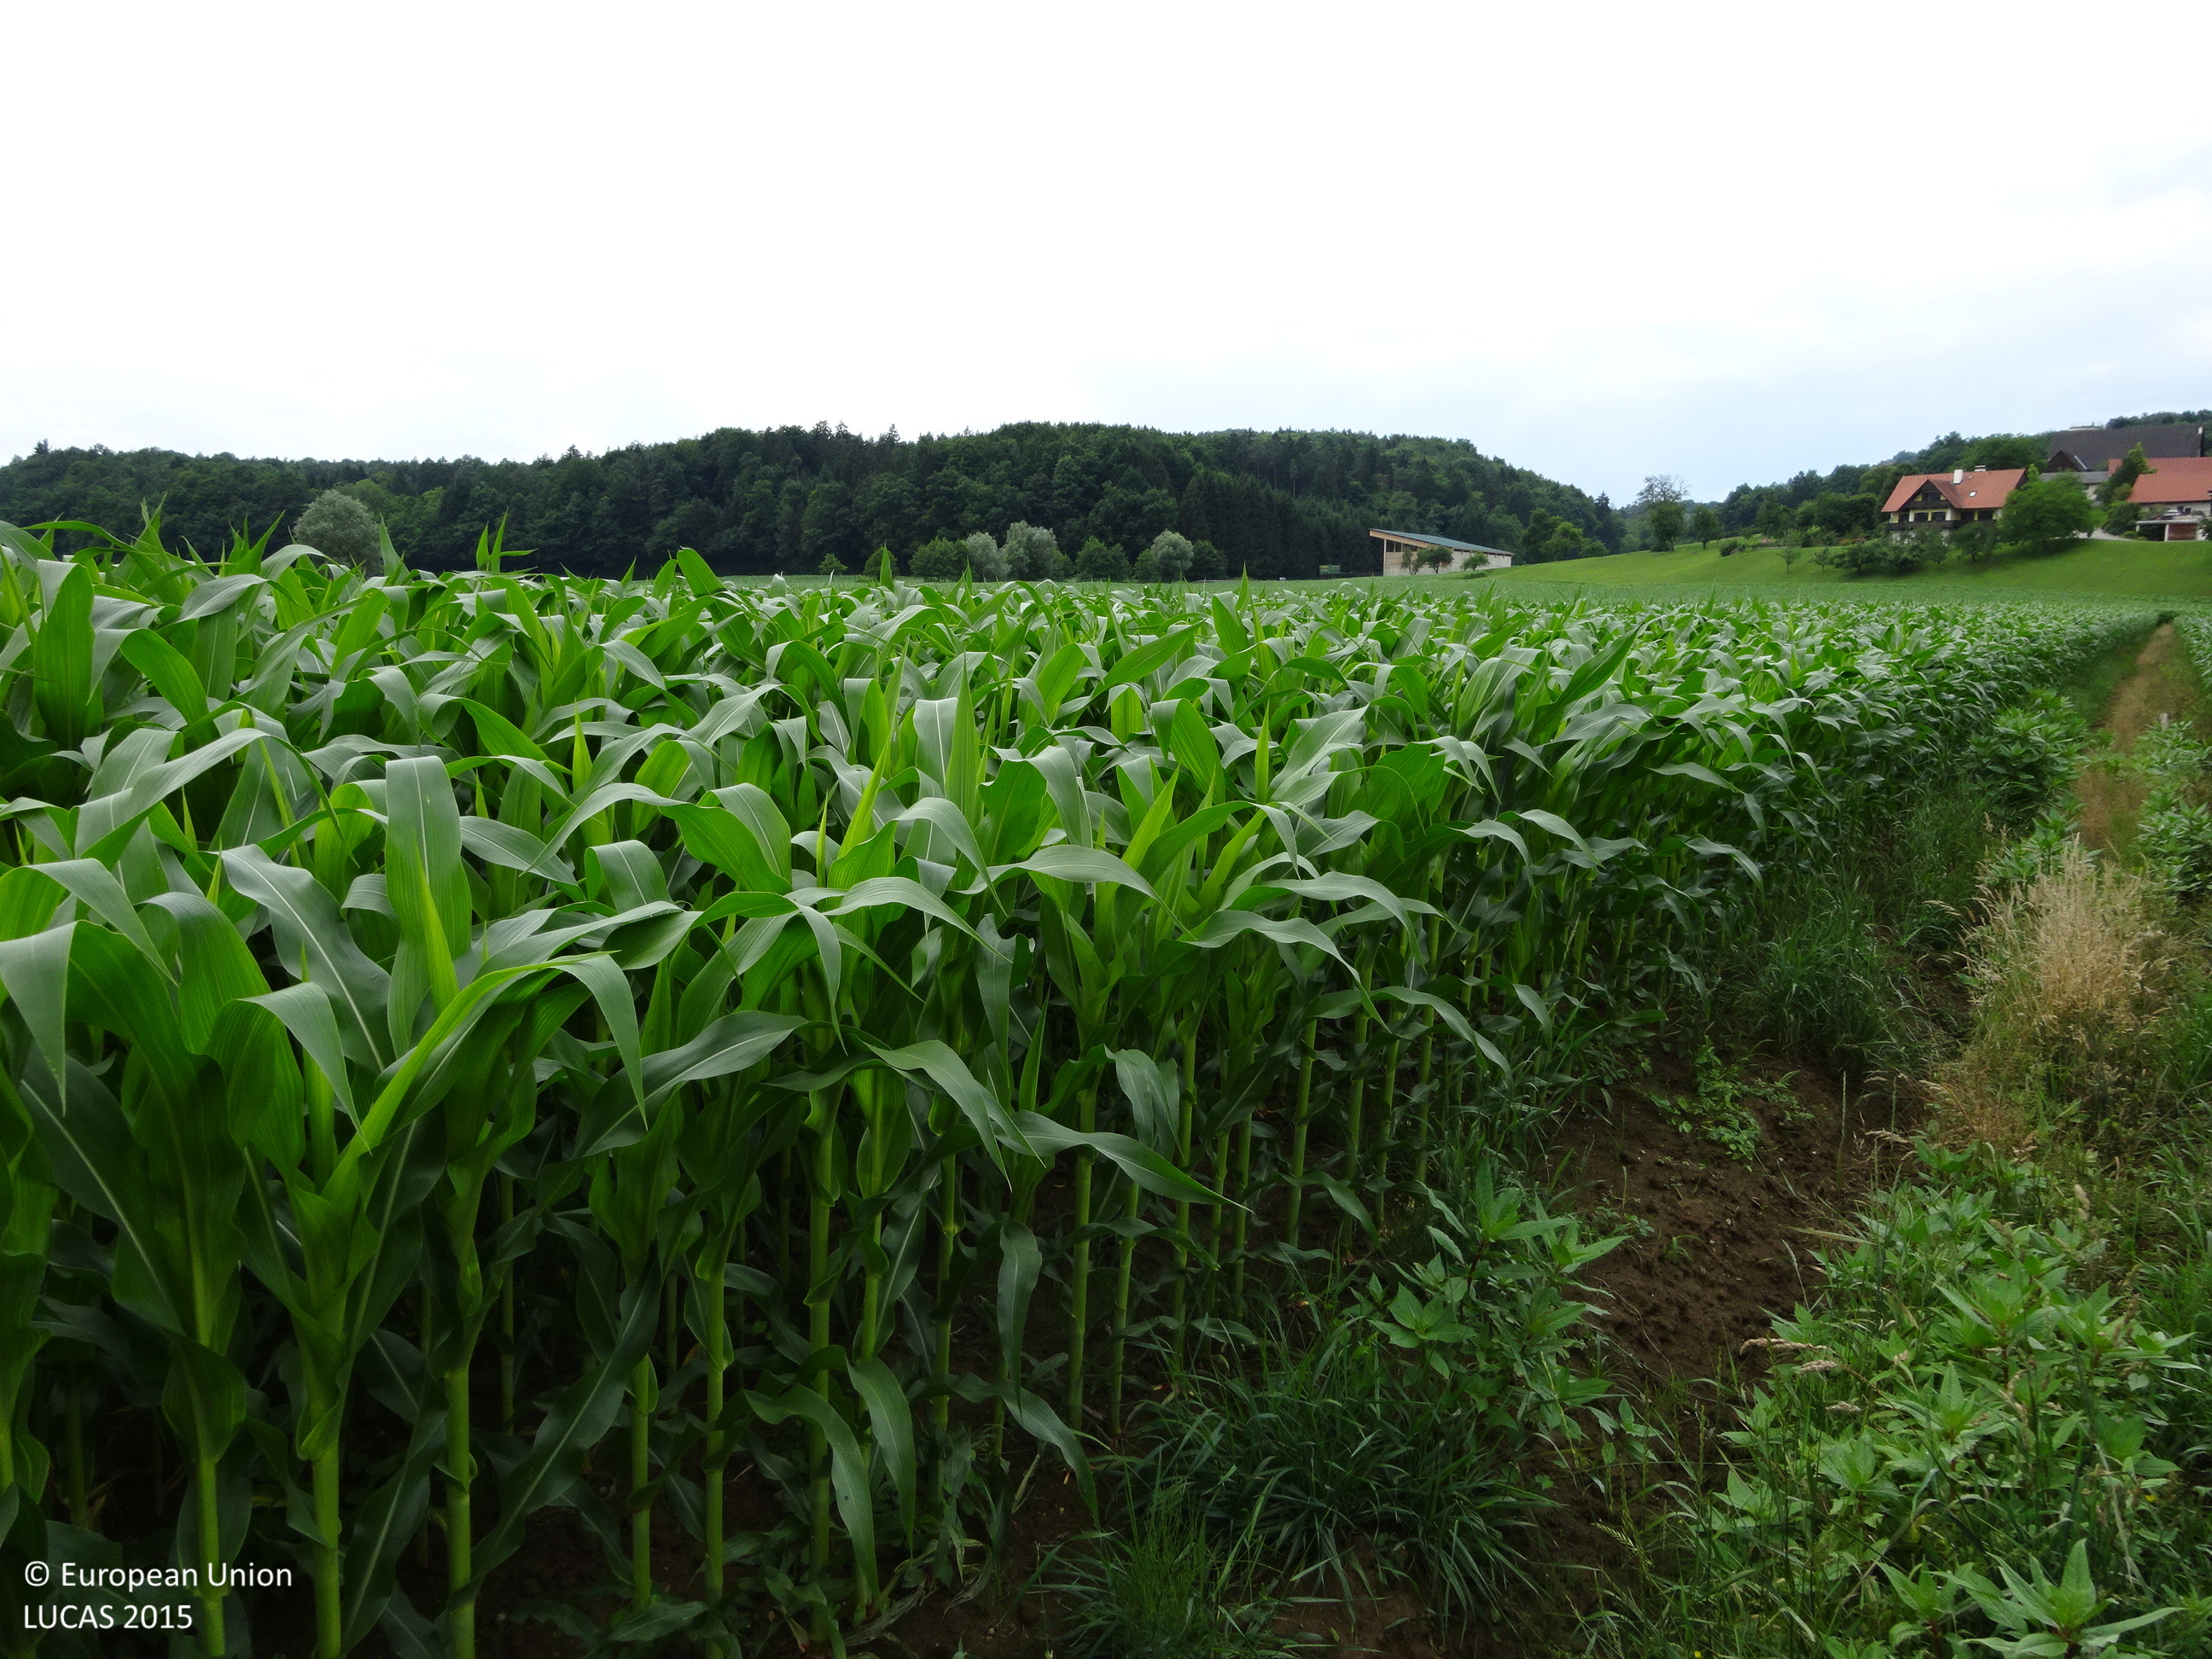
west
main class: Cropland
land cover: Maize
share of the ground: > 75 %
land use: Agriculture (excluding fallow land and kitchen gardens)
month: June
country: AT
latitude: 46.7367
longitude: 15.4302
